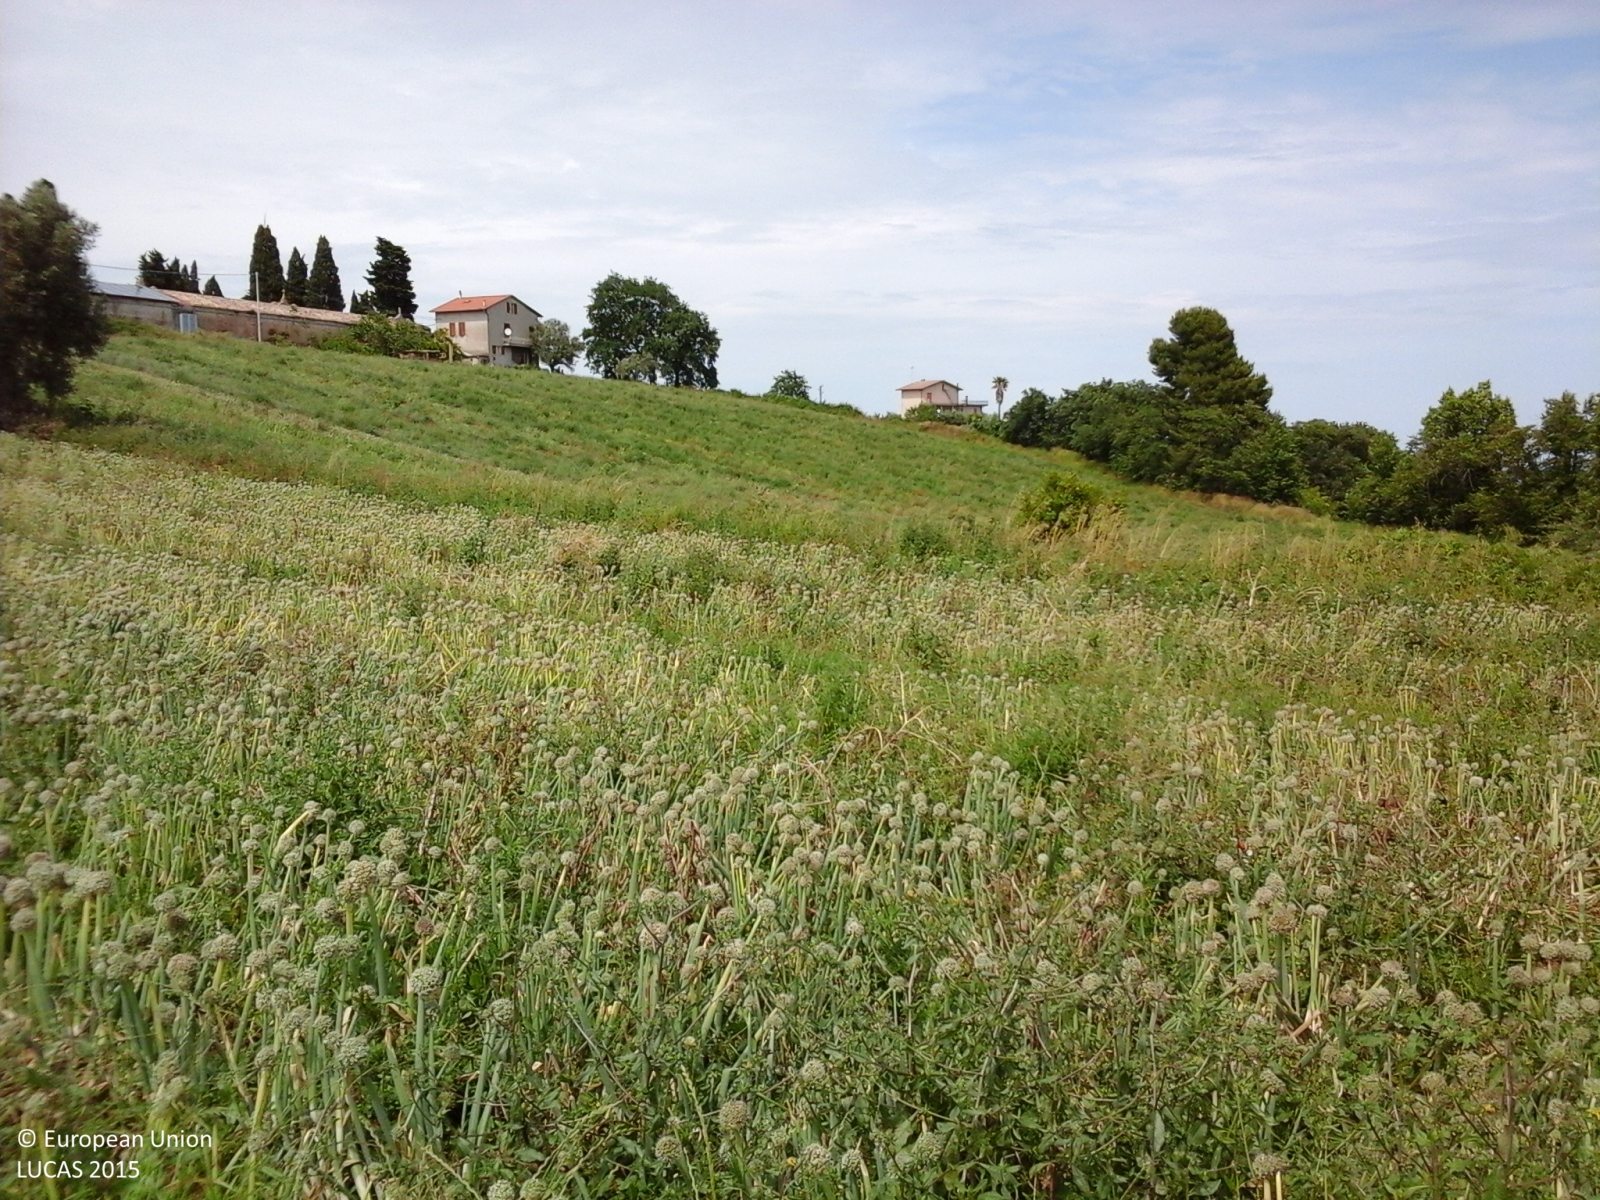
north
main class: Cropland
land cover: Other root crops
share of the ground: > 75 %
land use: Agriculture (excluding fallow land and kitchen gardens)
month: May
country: IT
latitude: 43.0145
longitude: 13.8547
